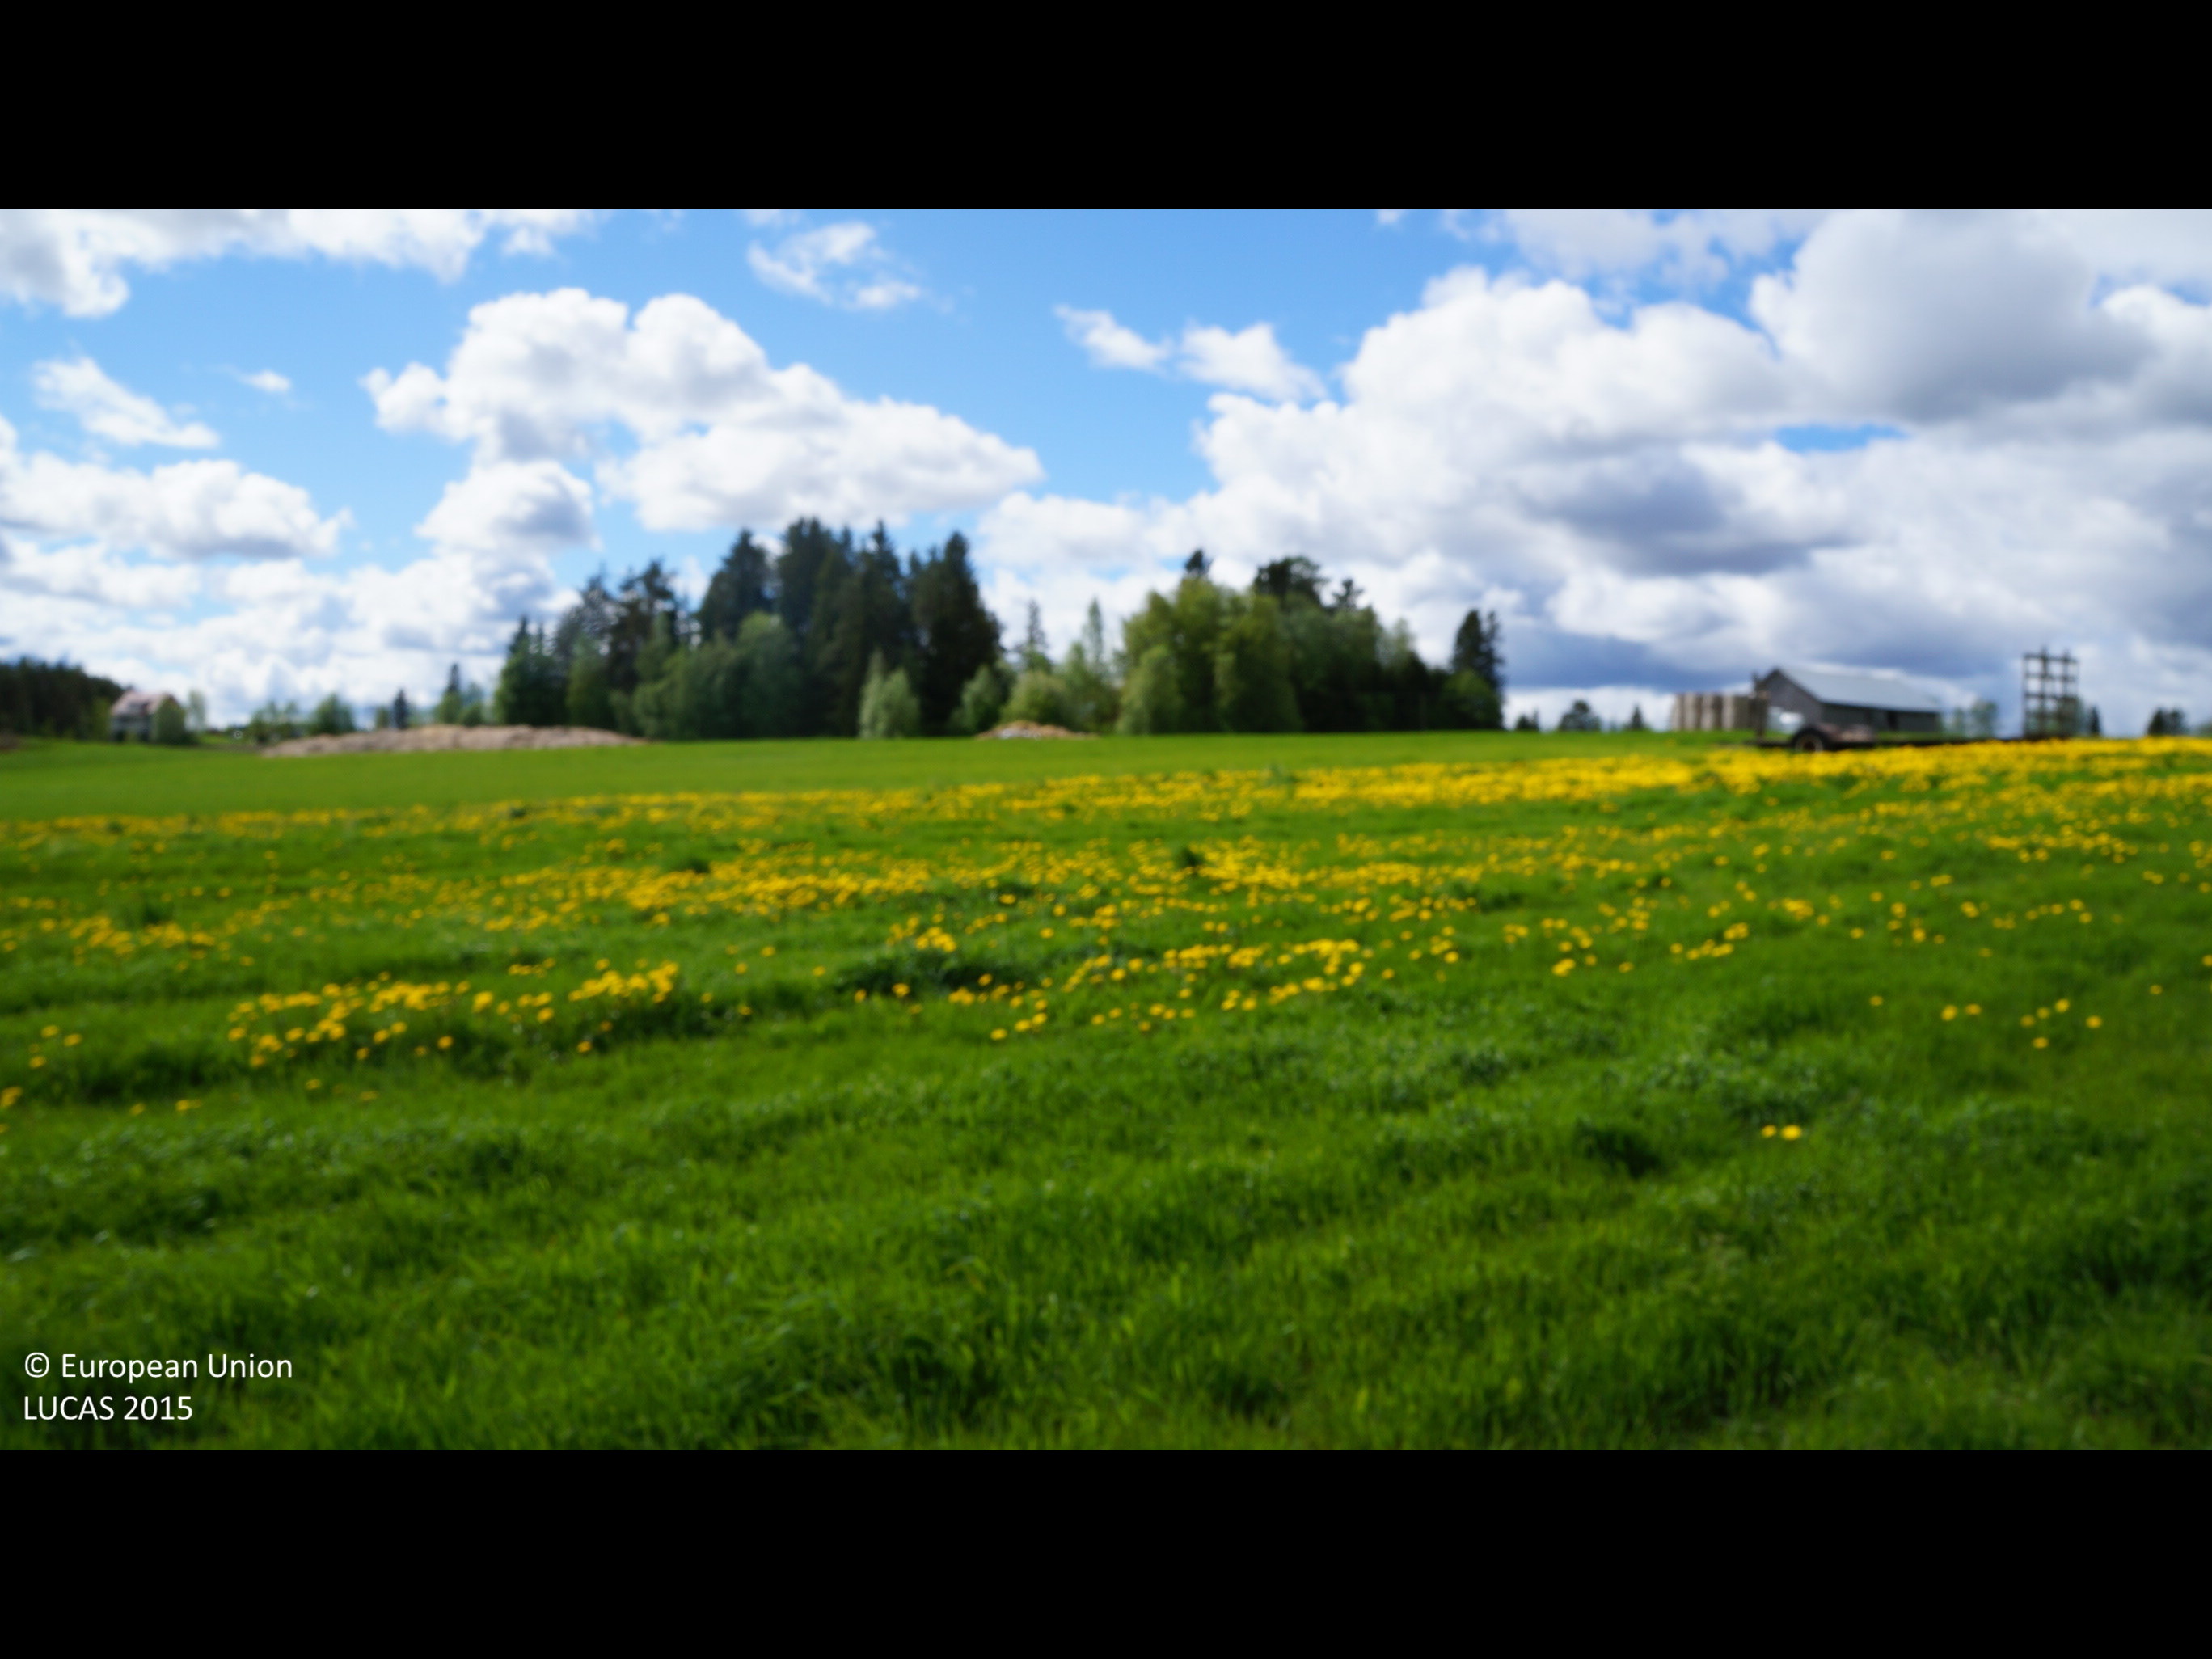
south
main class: Cropland
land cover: Temporary grasslands
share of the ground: > 75 %
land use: Agriculture (excluding fallow land and kitchen gardens)
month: June
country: FI
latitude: 63.7657
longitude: 24.2868
